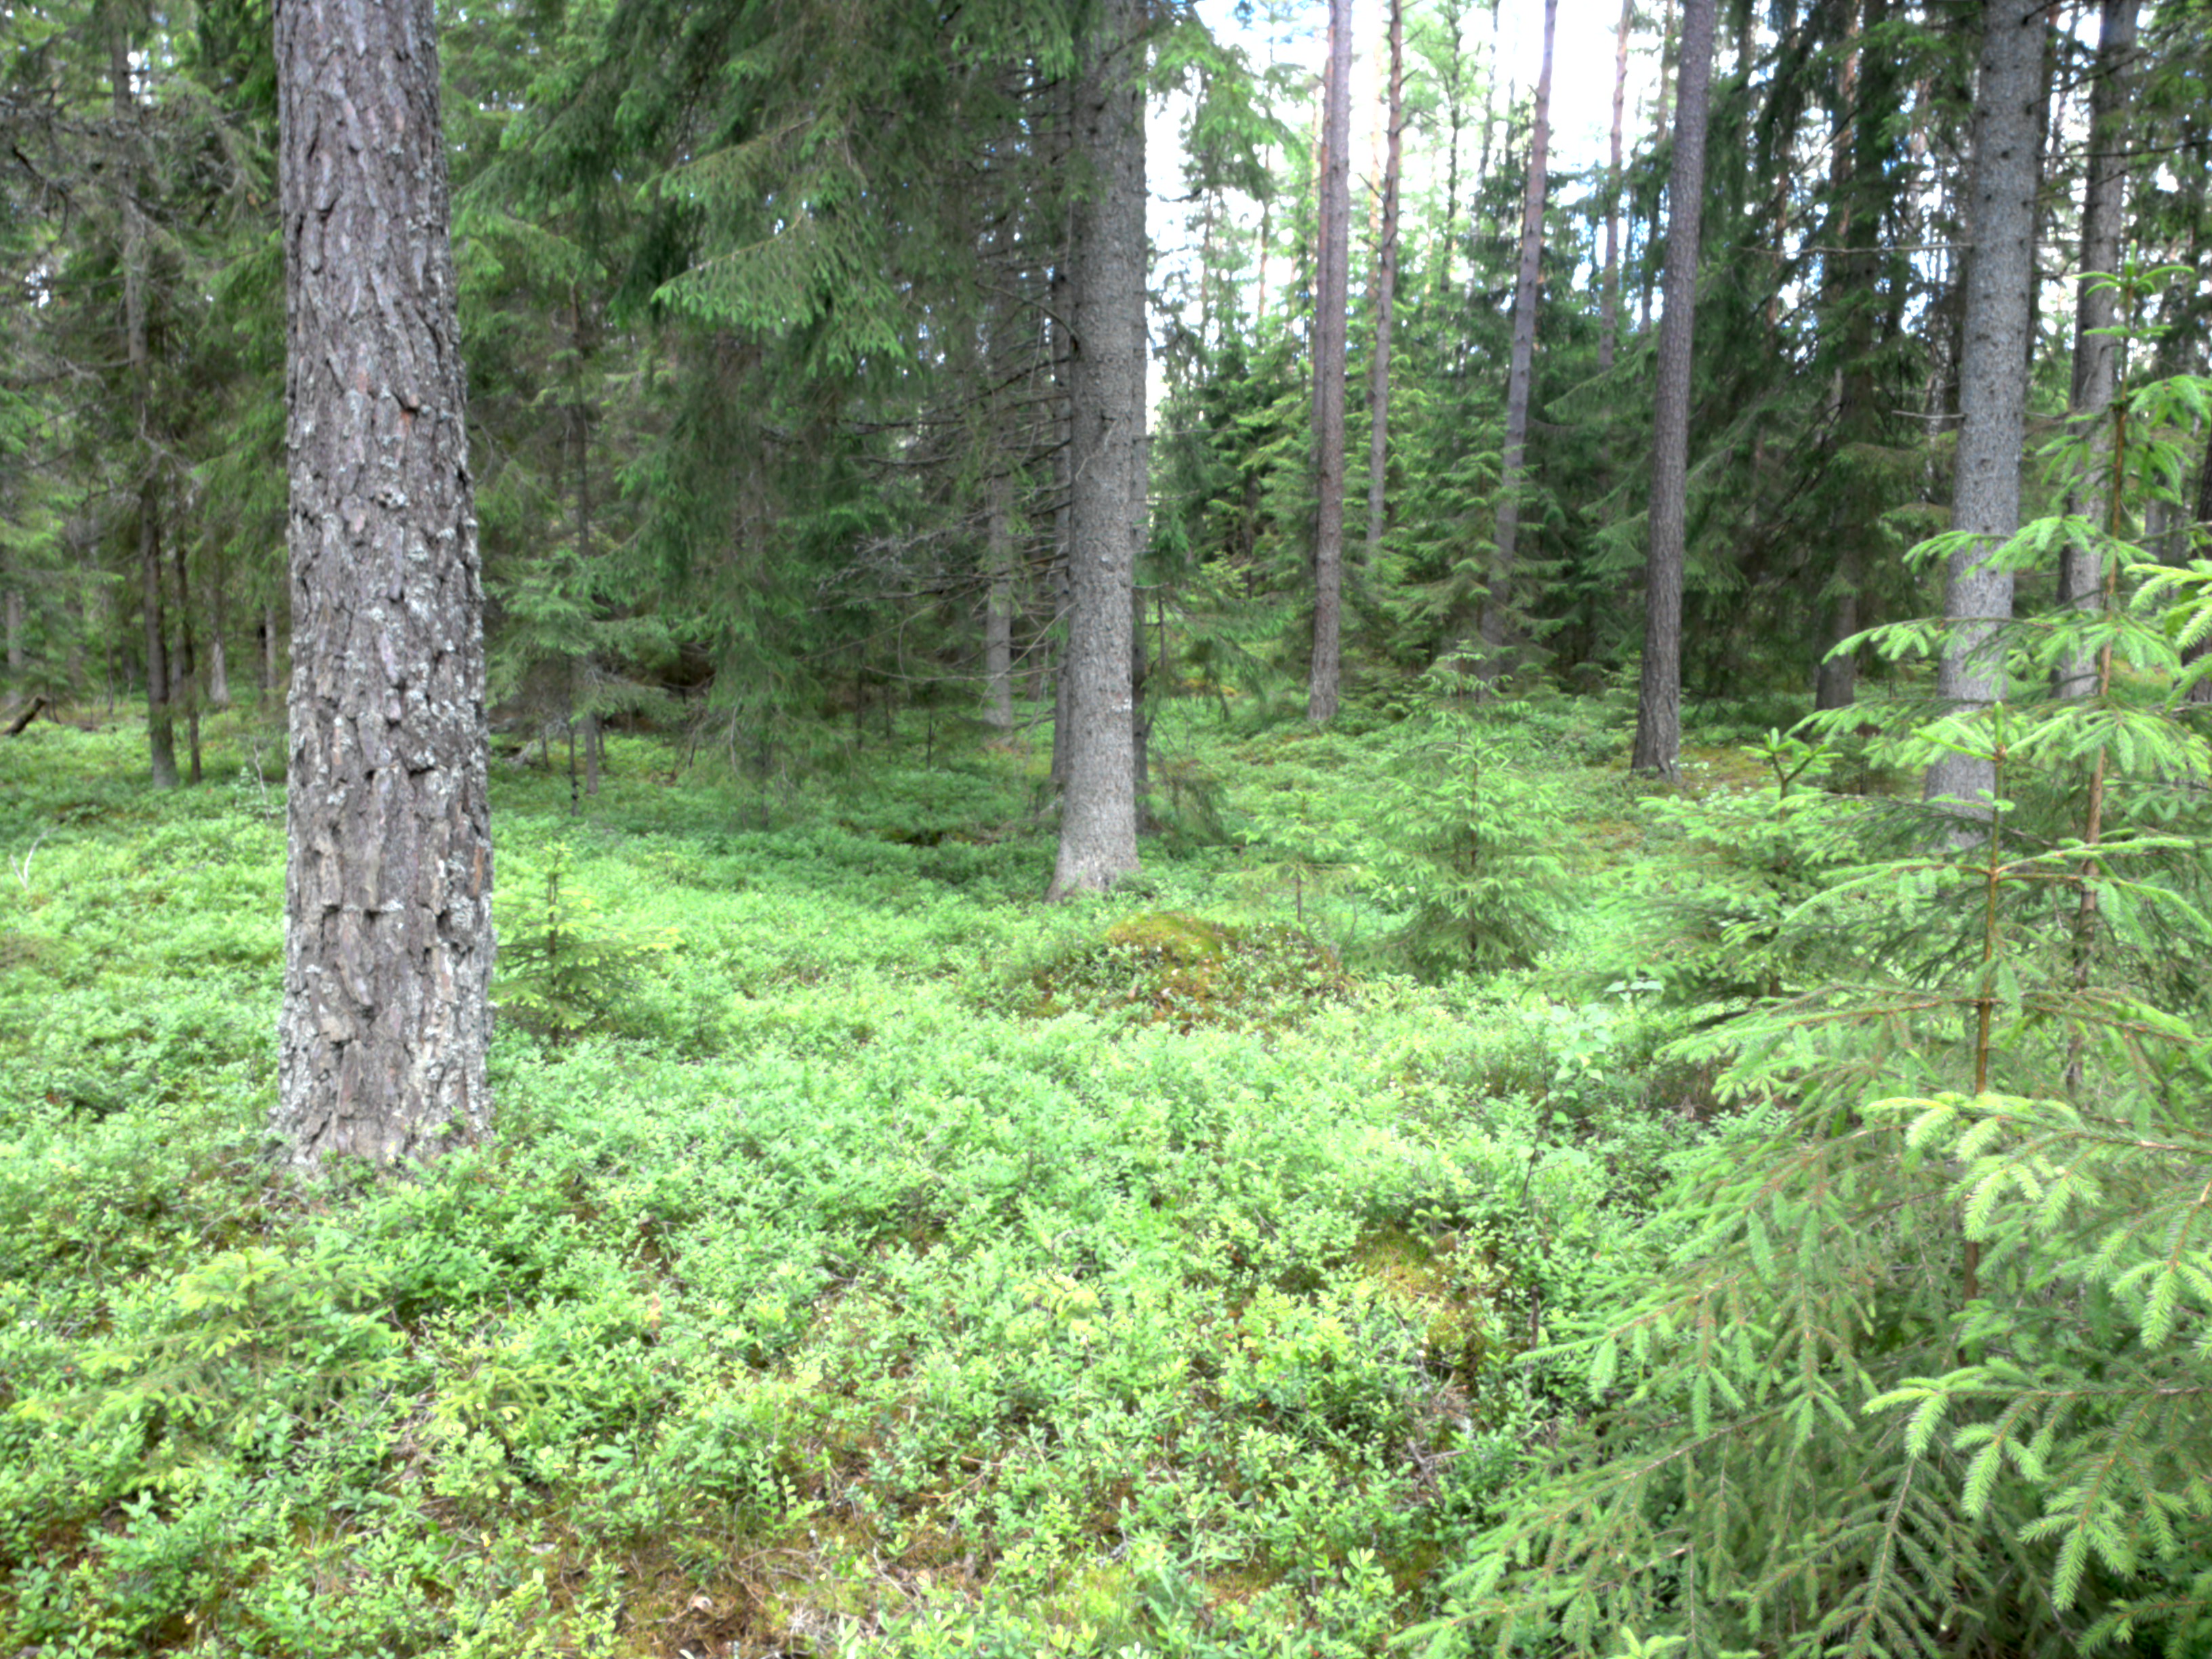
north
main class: Woodland
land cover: Pine dominated coniferous woodland
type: boreal forest
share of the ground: 50 - 75 %
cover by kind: coniferous forest trees 70 %, shrubs 20 %, lichens and mosses 10 %
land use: Forestry
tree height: > 5 m
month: June
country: SE
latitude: 59.2187
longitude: 17.5474
